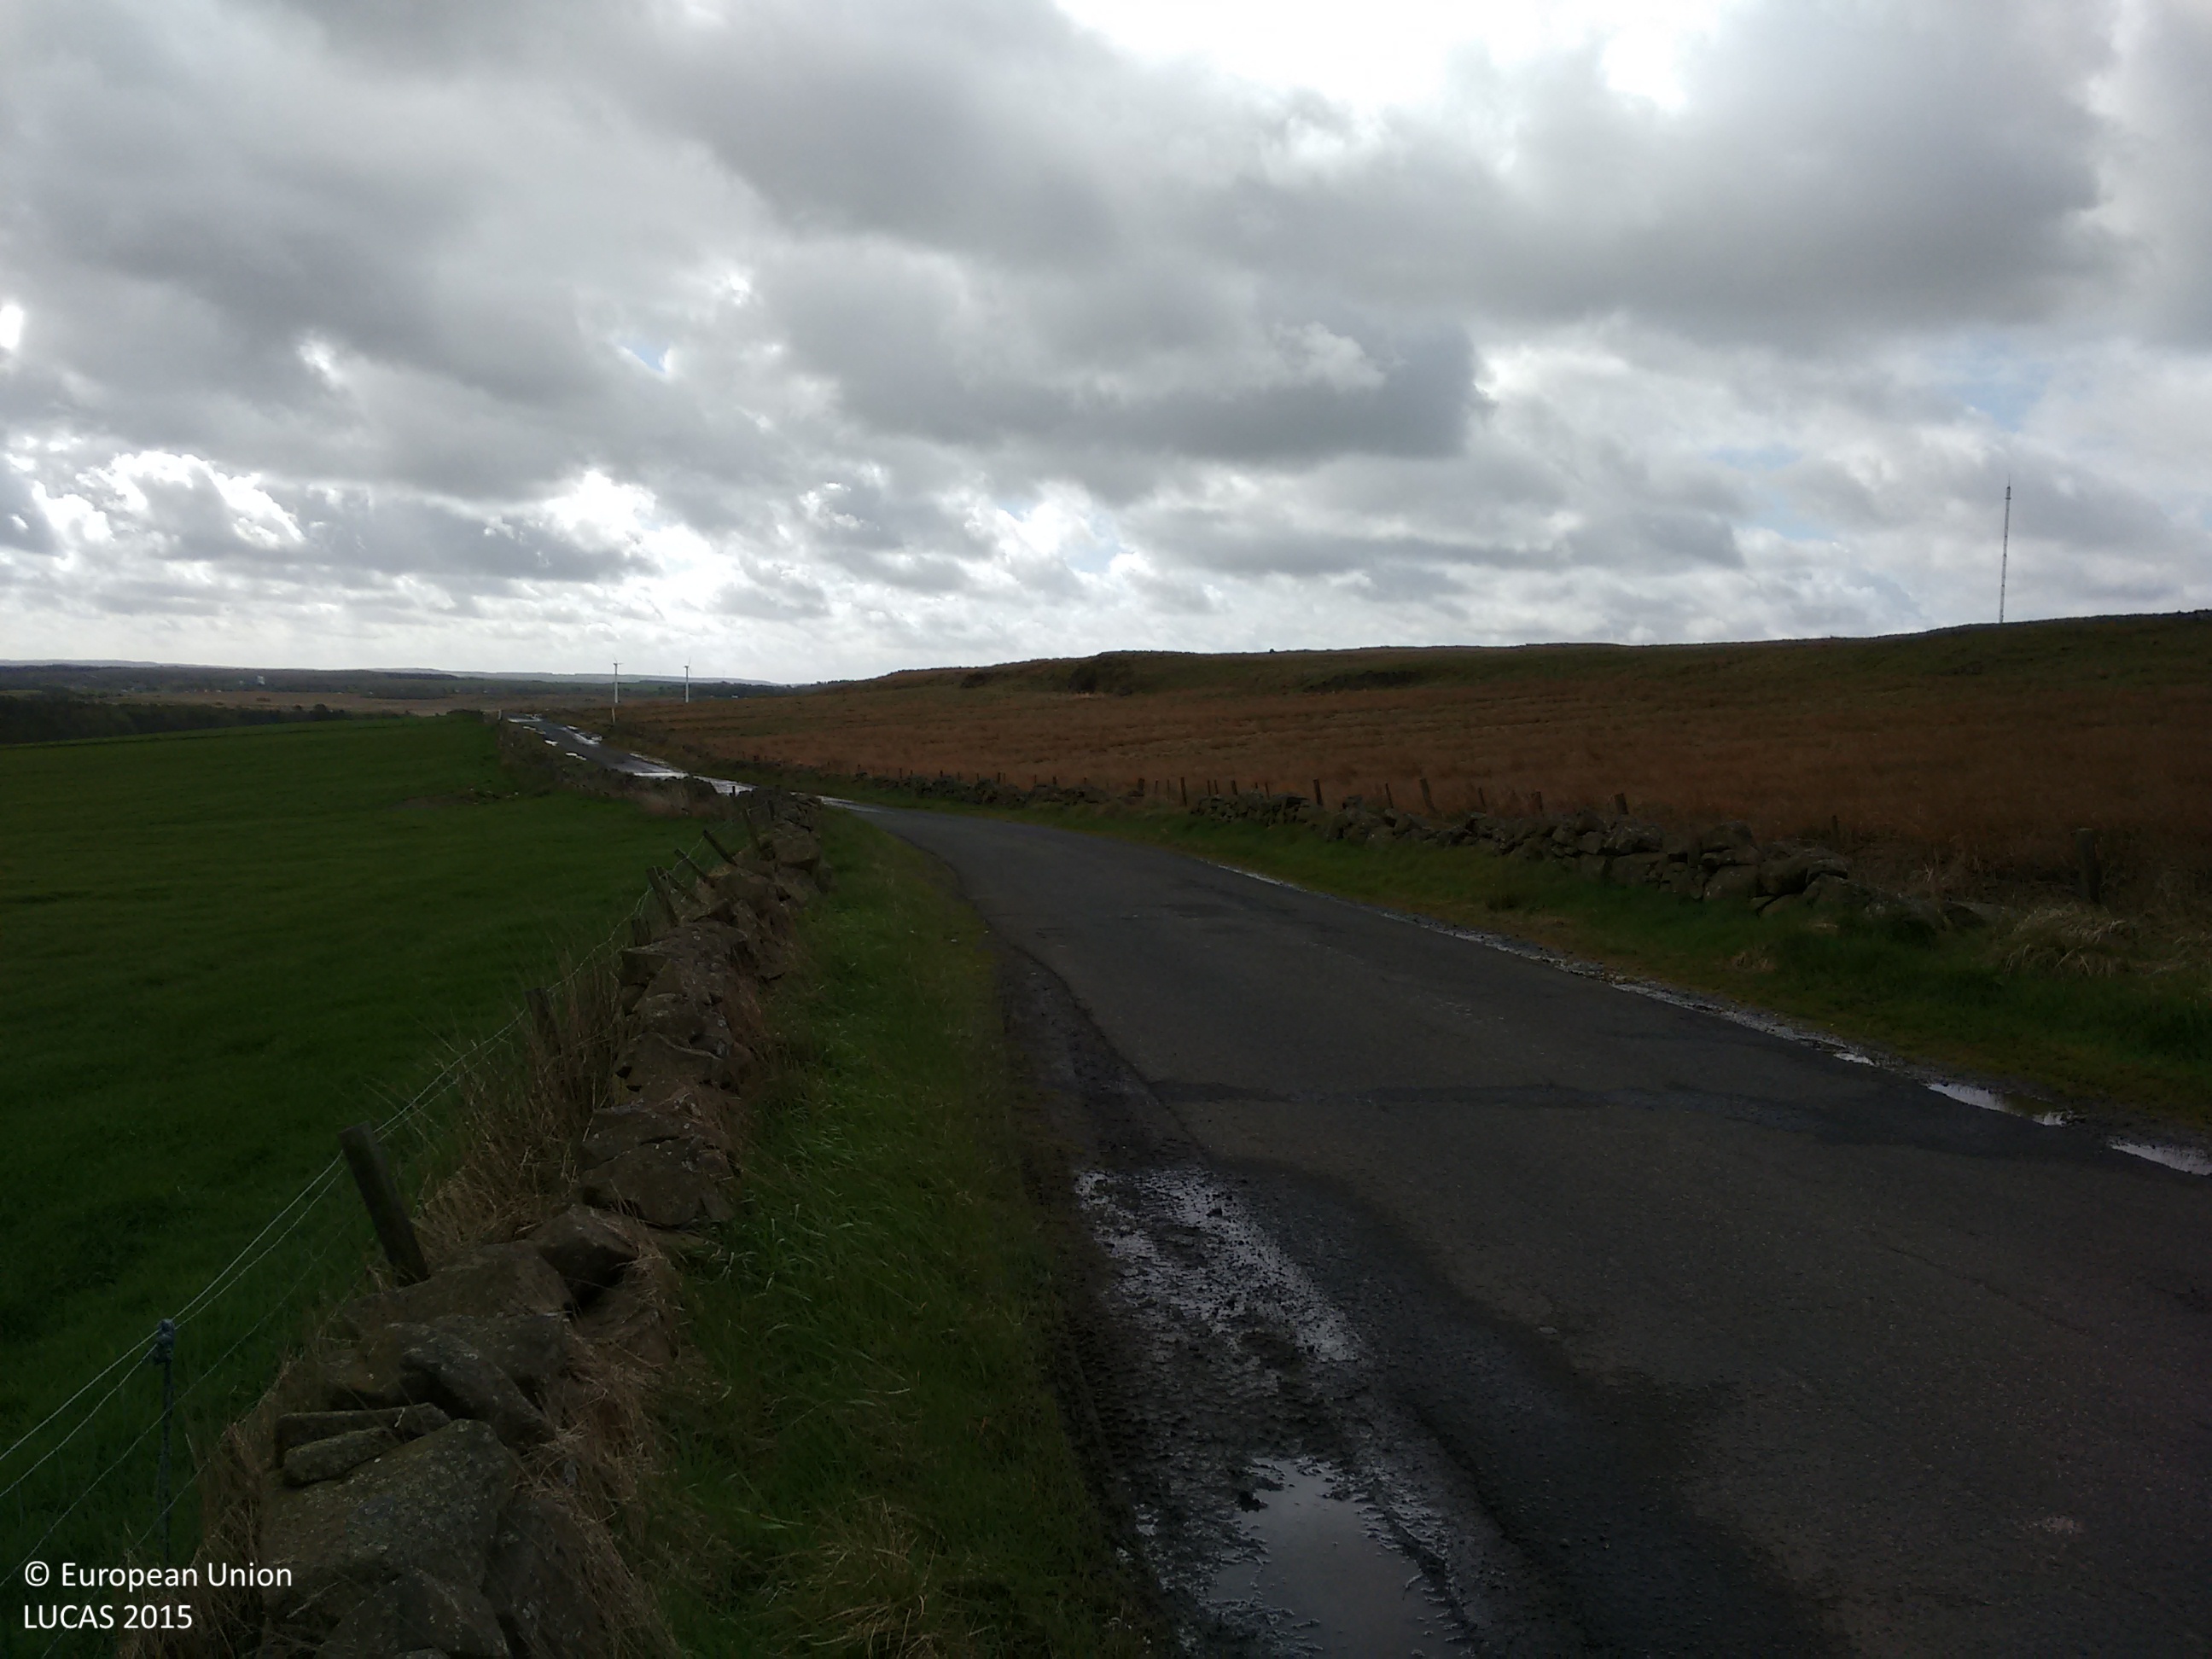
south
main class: Grassland
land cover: Grassland without tree/shrub cover
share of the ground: > 75 %
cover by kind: herbaceous plants 100 %
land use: Agriculture (excluding fallow land and kitchen gardens)
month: May
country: GB
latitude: 55.8743
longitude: -3.8132
